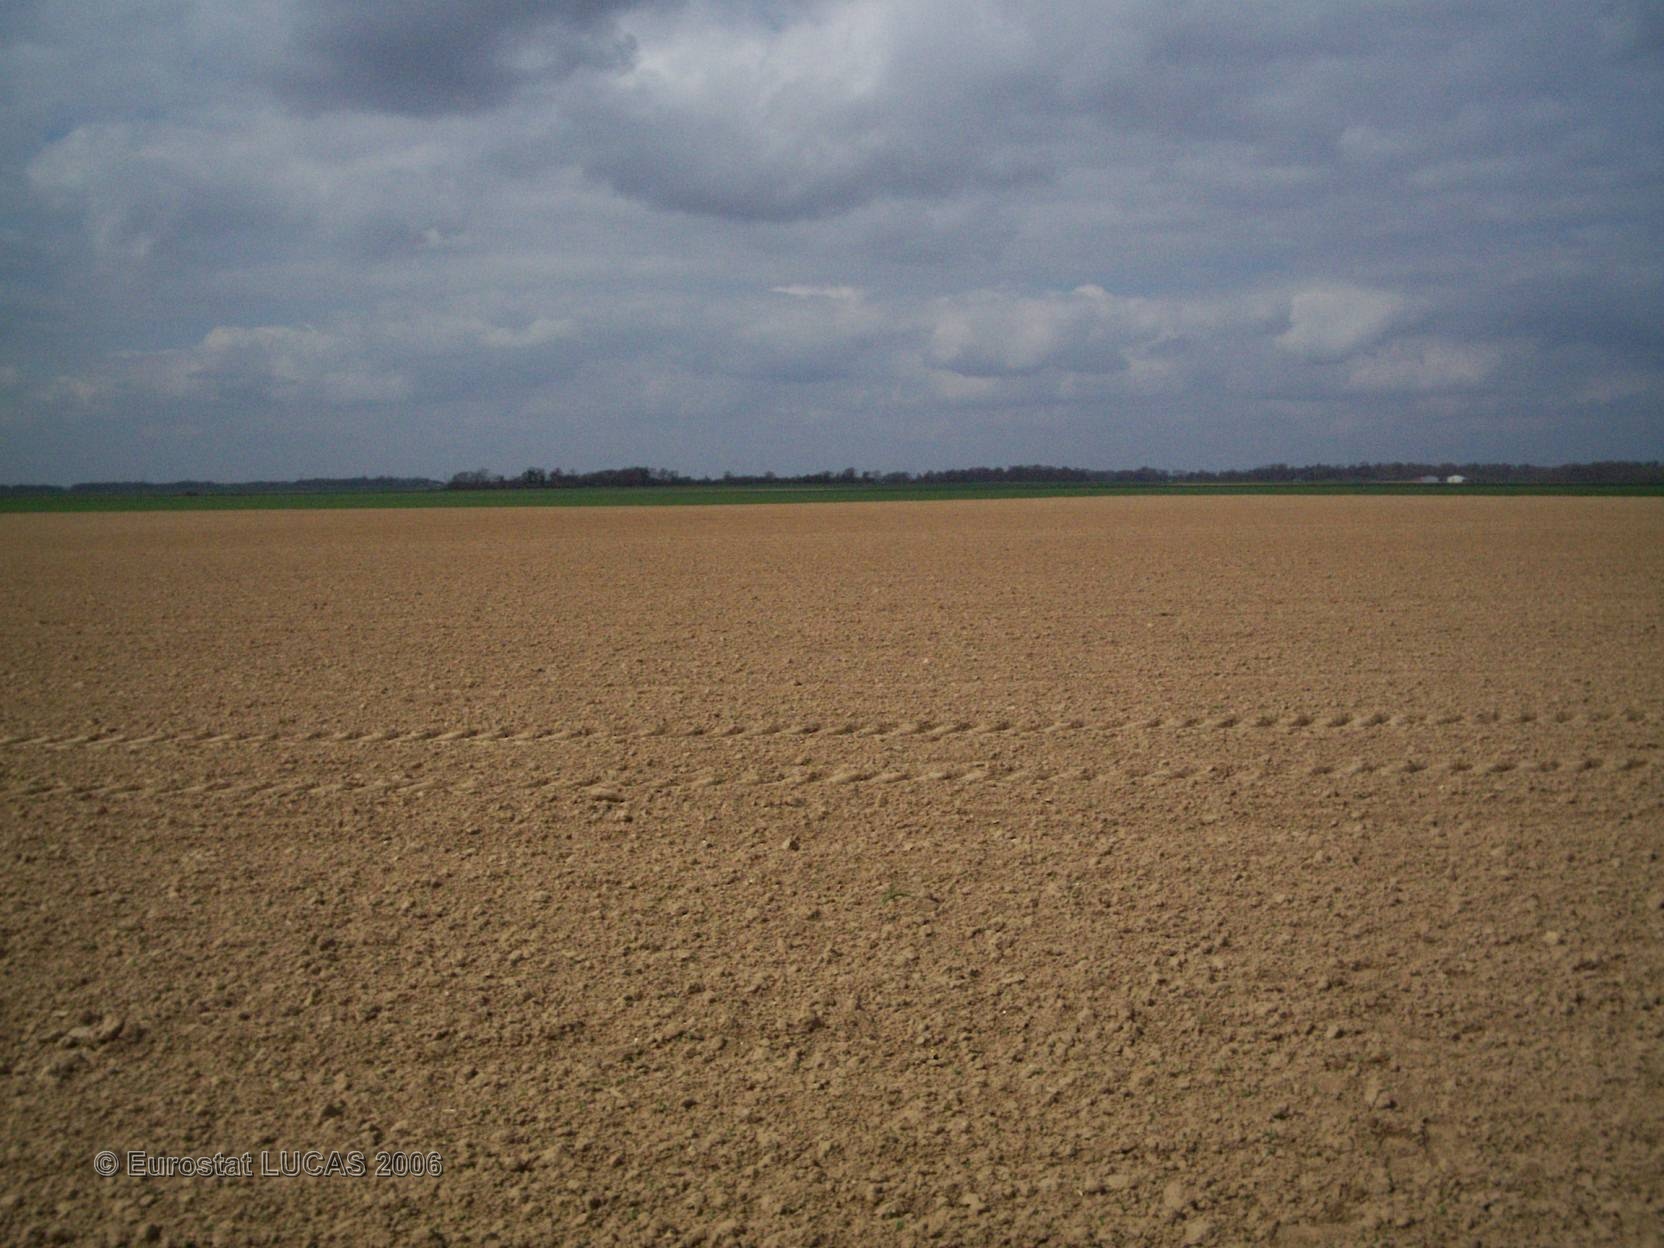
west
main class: Cropland
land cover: Dry pulses
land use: Agriculture (excluding fallow land and kitchen gardens)
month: April
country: FR
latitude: 49.0865
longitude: 1.0097
